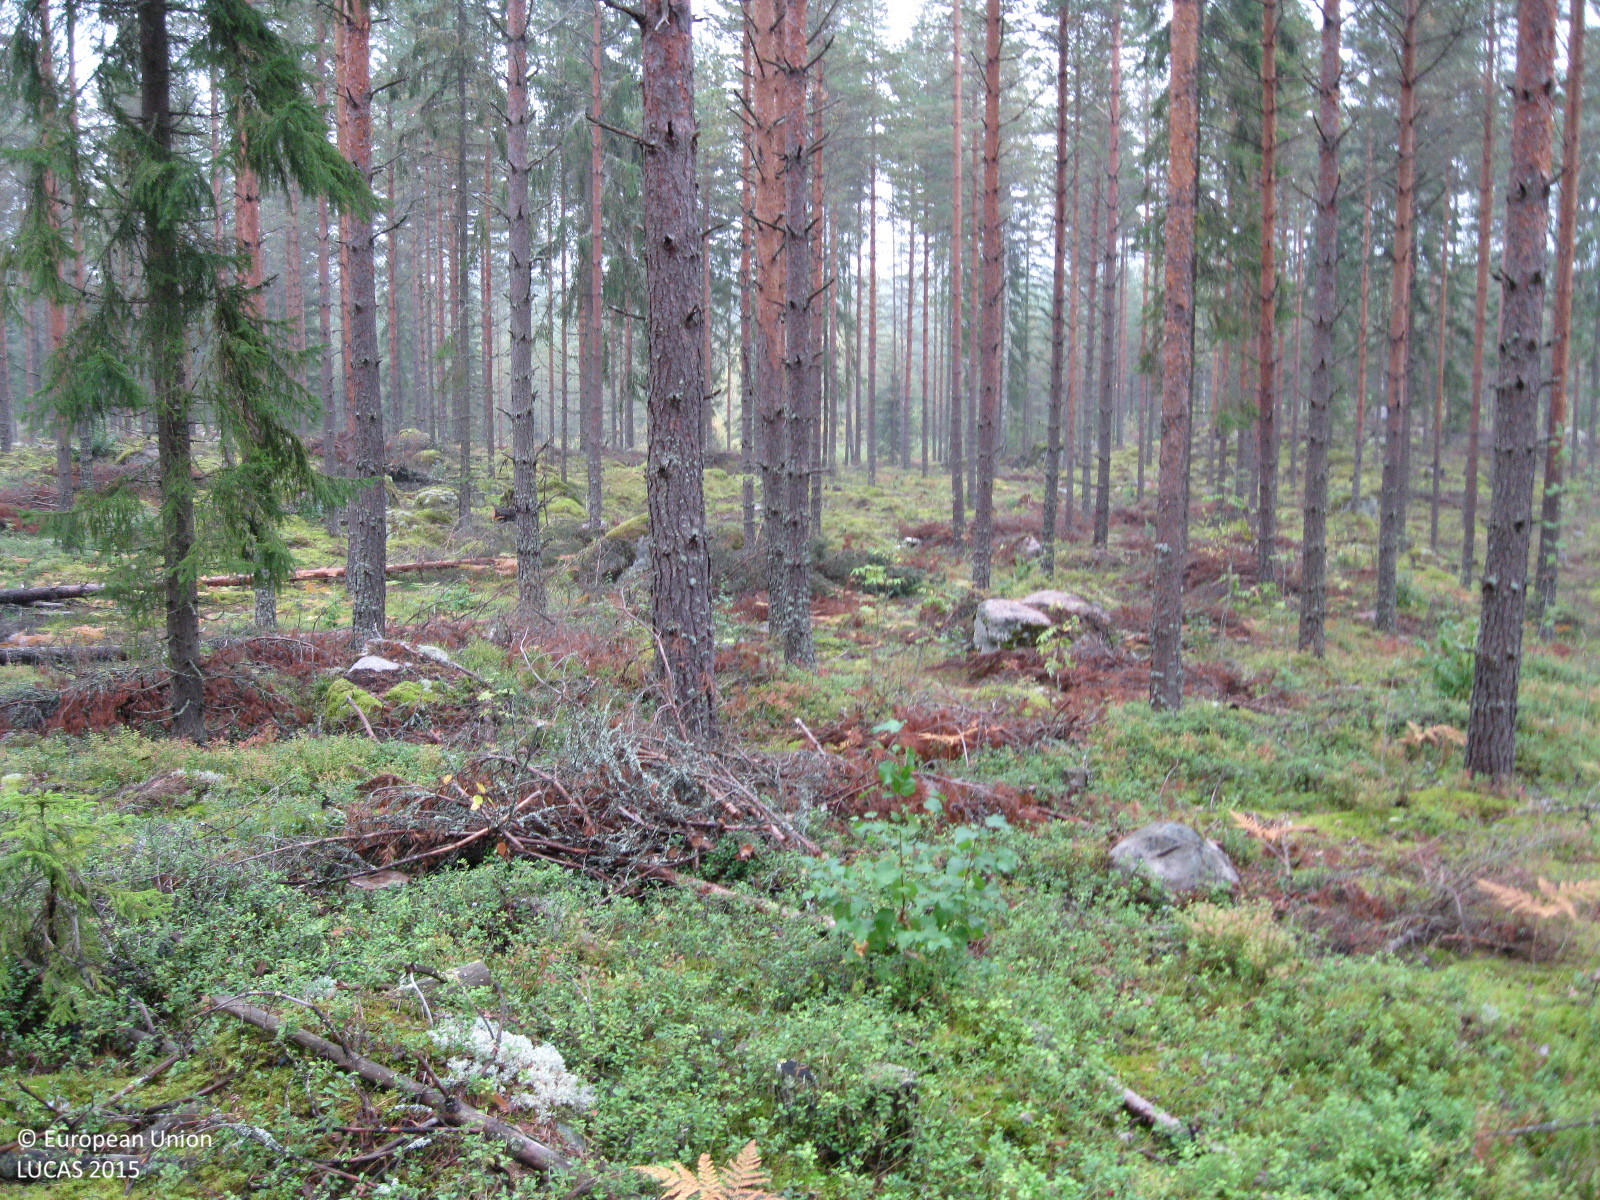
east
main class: Woodland
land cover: Pine dominated coniferous woodland
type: boreal forest
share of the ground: 50 - 75 %
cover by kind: coniferous forest trees 55 %, shrubs 30 %, lichens and mosses 15 %
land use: Forestry
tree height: > 5 m
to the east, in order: Pine dominated coniferous woodland; Tracks; Pine dominated coniferous woodland; Tracks; Pine dominated coniferous woodland; Grassland with sparse tree/shrub cover; Electric lines; Grassland with sparse tree/shrub cover; Pine dominated coniferous woodland; Pine dominated mixed woodland; Grassland without tree/shrub cover; Pine dominated coniferous woodland
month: September
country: FI
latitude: 60.8925
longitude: 24.8728
